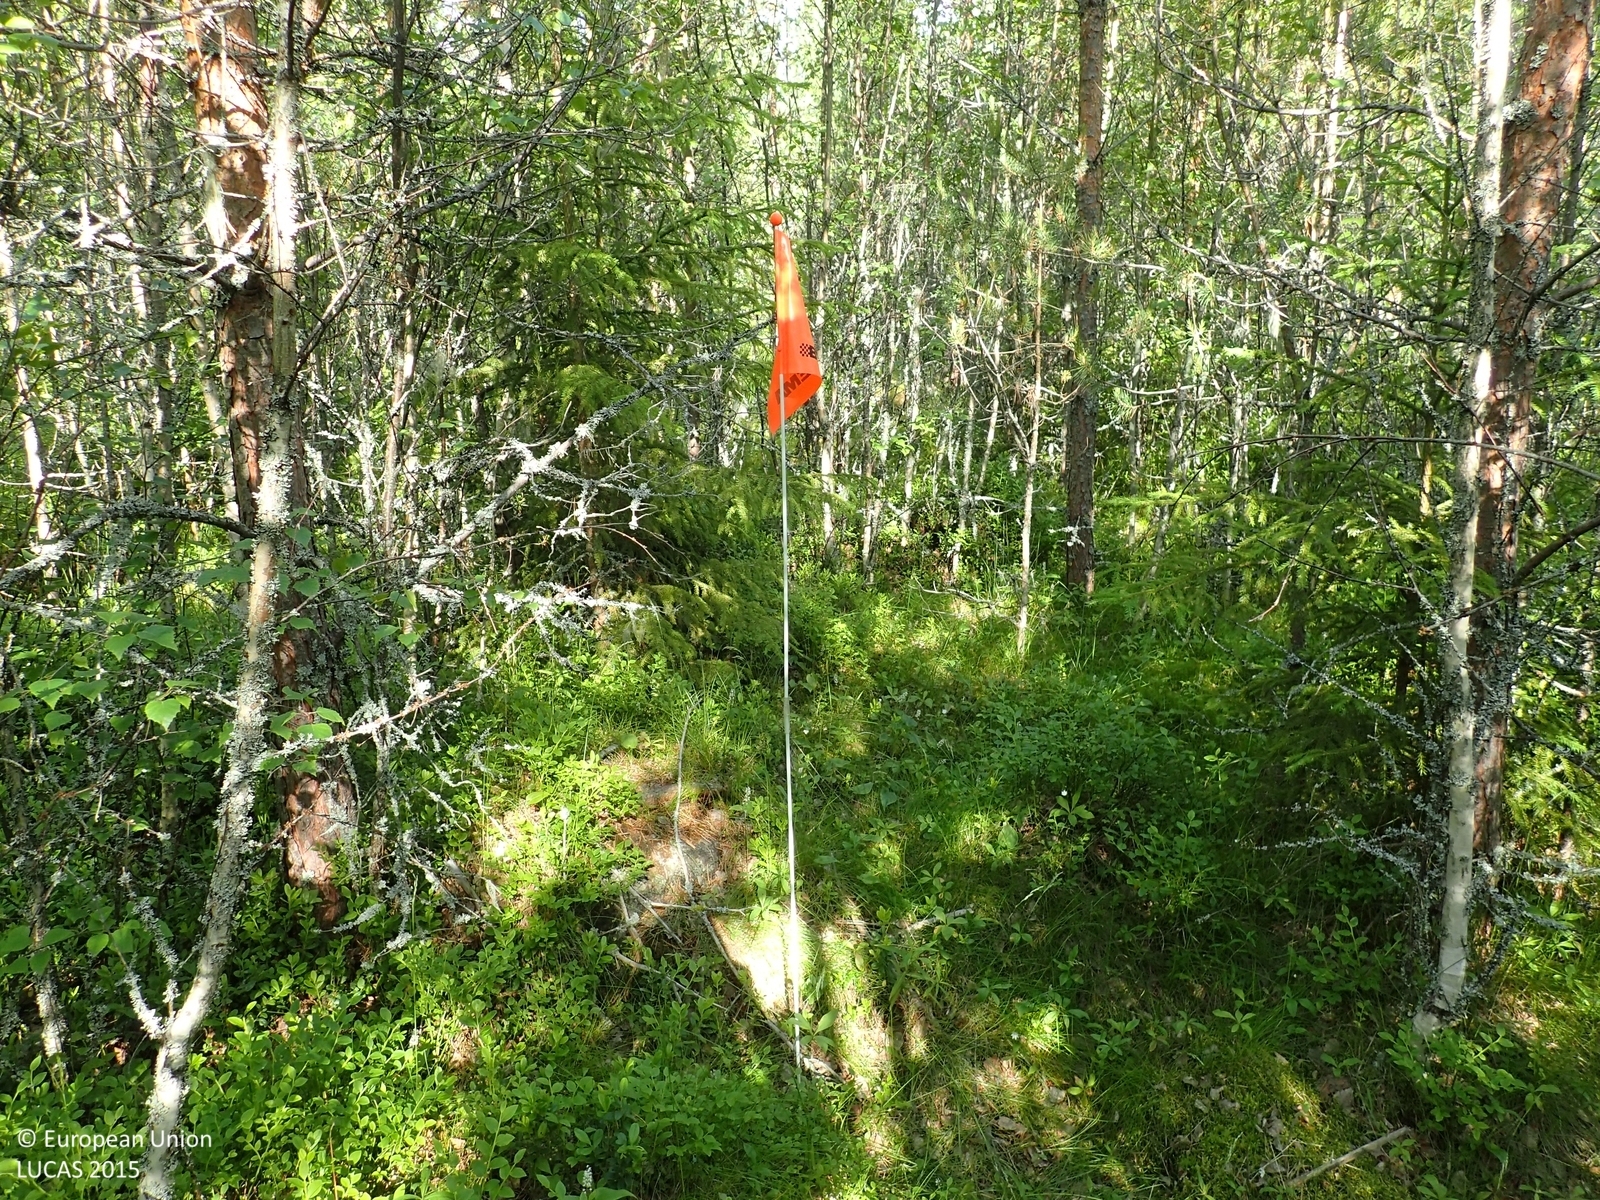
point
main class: Woodland
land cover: Pine dominated mixed woodland
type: boreal forest
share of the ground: > 75 %
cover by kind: coniferous forest trees 40 %, broadleaved forest trees 40 %, shrubs 10 %, herbaceous plants 10 %
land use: Forestry
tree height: > 5 m
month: June
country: FI
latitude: 62.5036
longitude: 21.4392
